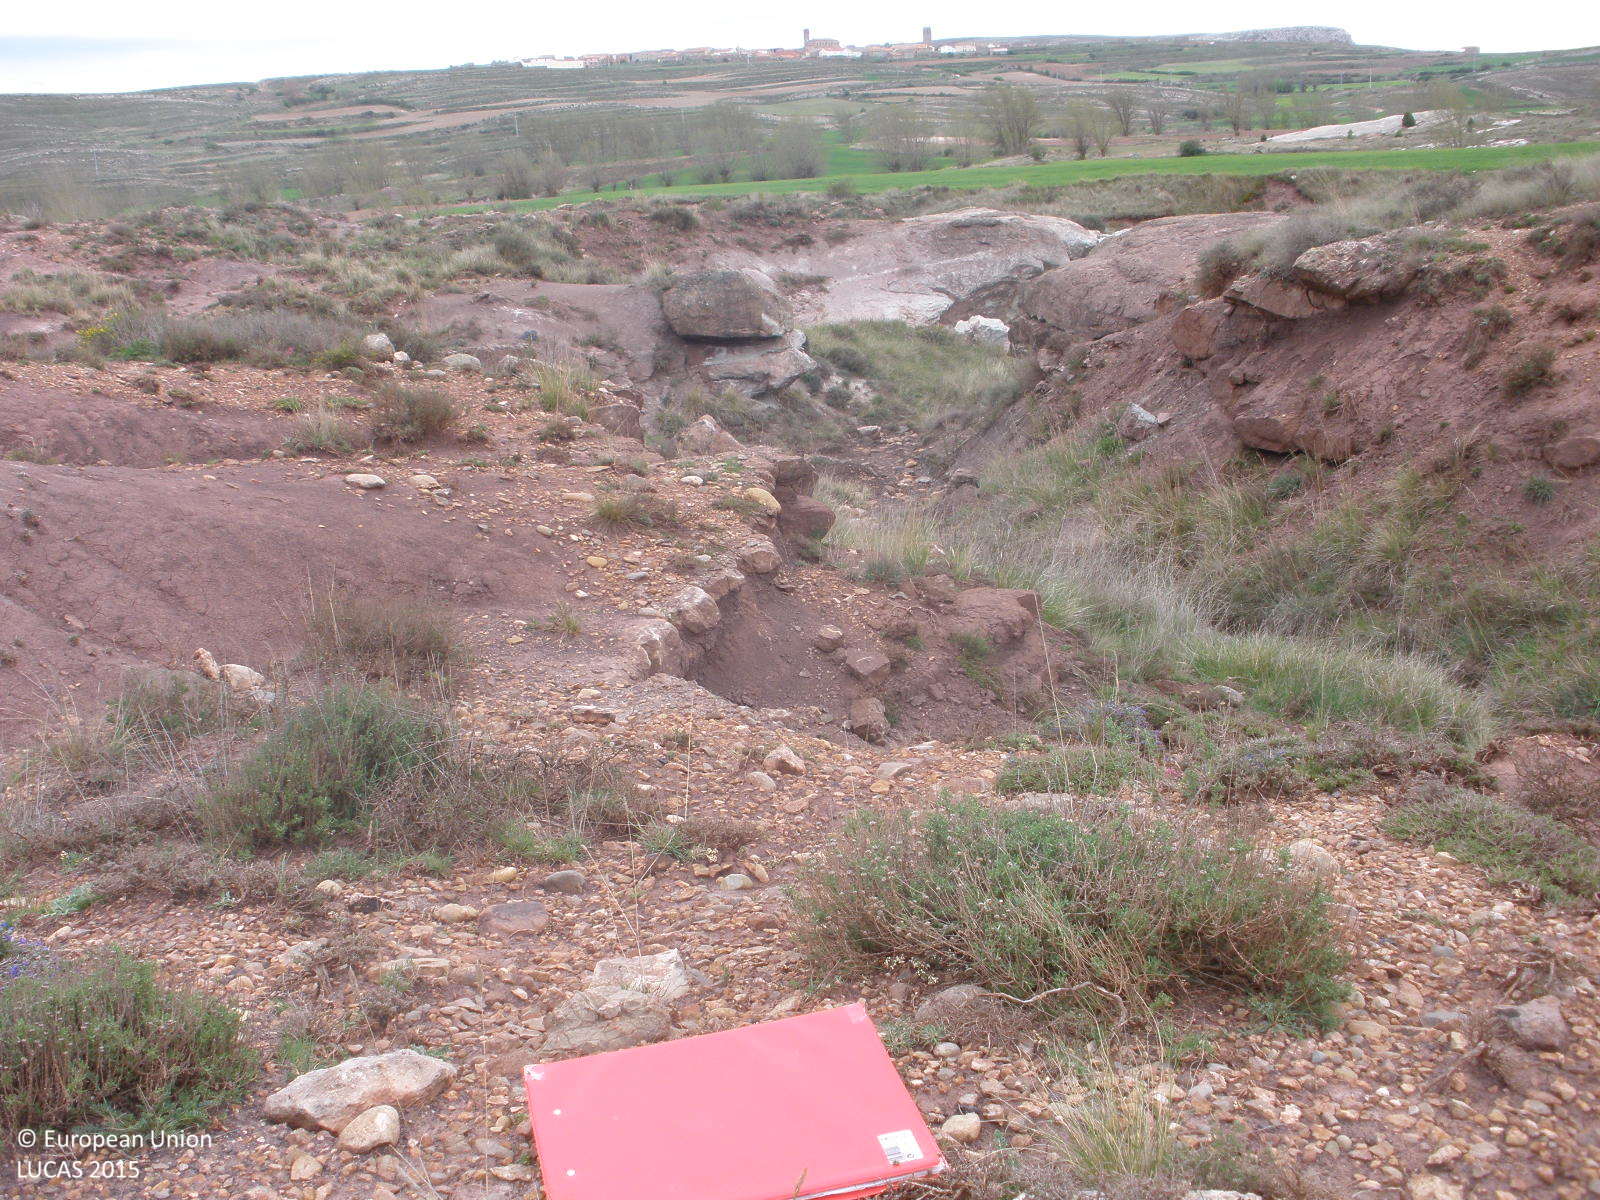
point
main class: Shrubland
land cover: Shrubland without tree cover
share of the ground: 25 - 50 %
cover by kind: consolidated bare surface 50 %, shrubs 30 %, herbaceous plants 20 %
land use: Semi-natural and natural areas not in use
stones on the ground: 10 - 25 %
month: May
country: ES
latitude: 40.5609
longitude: -0.8175
